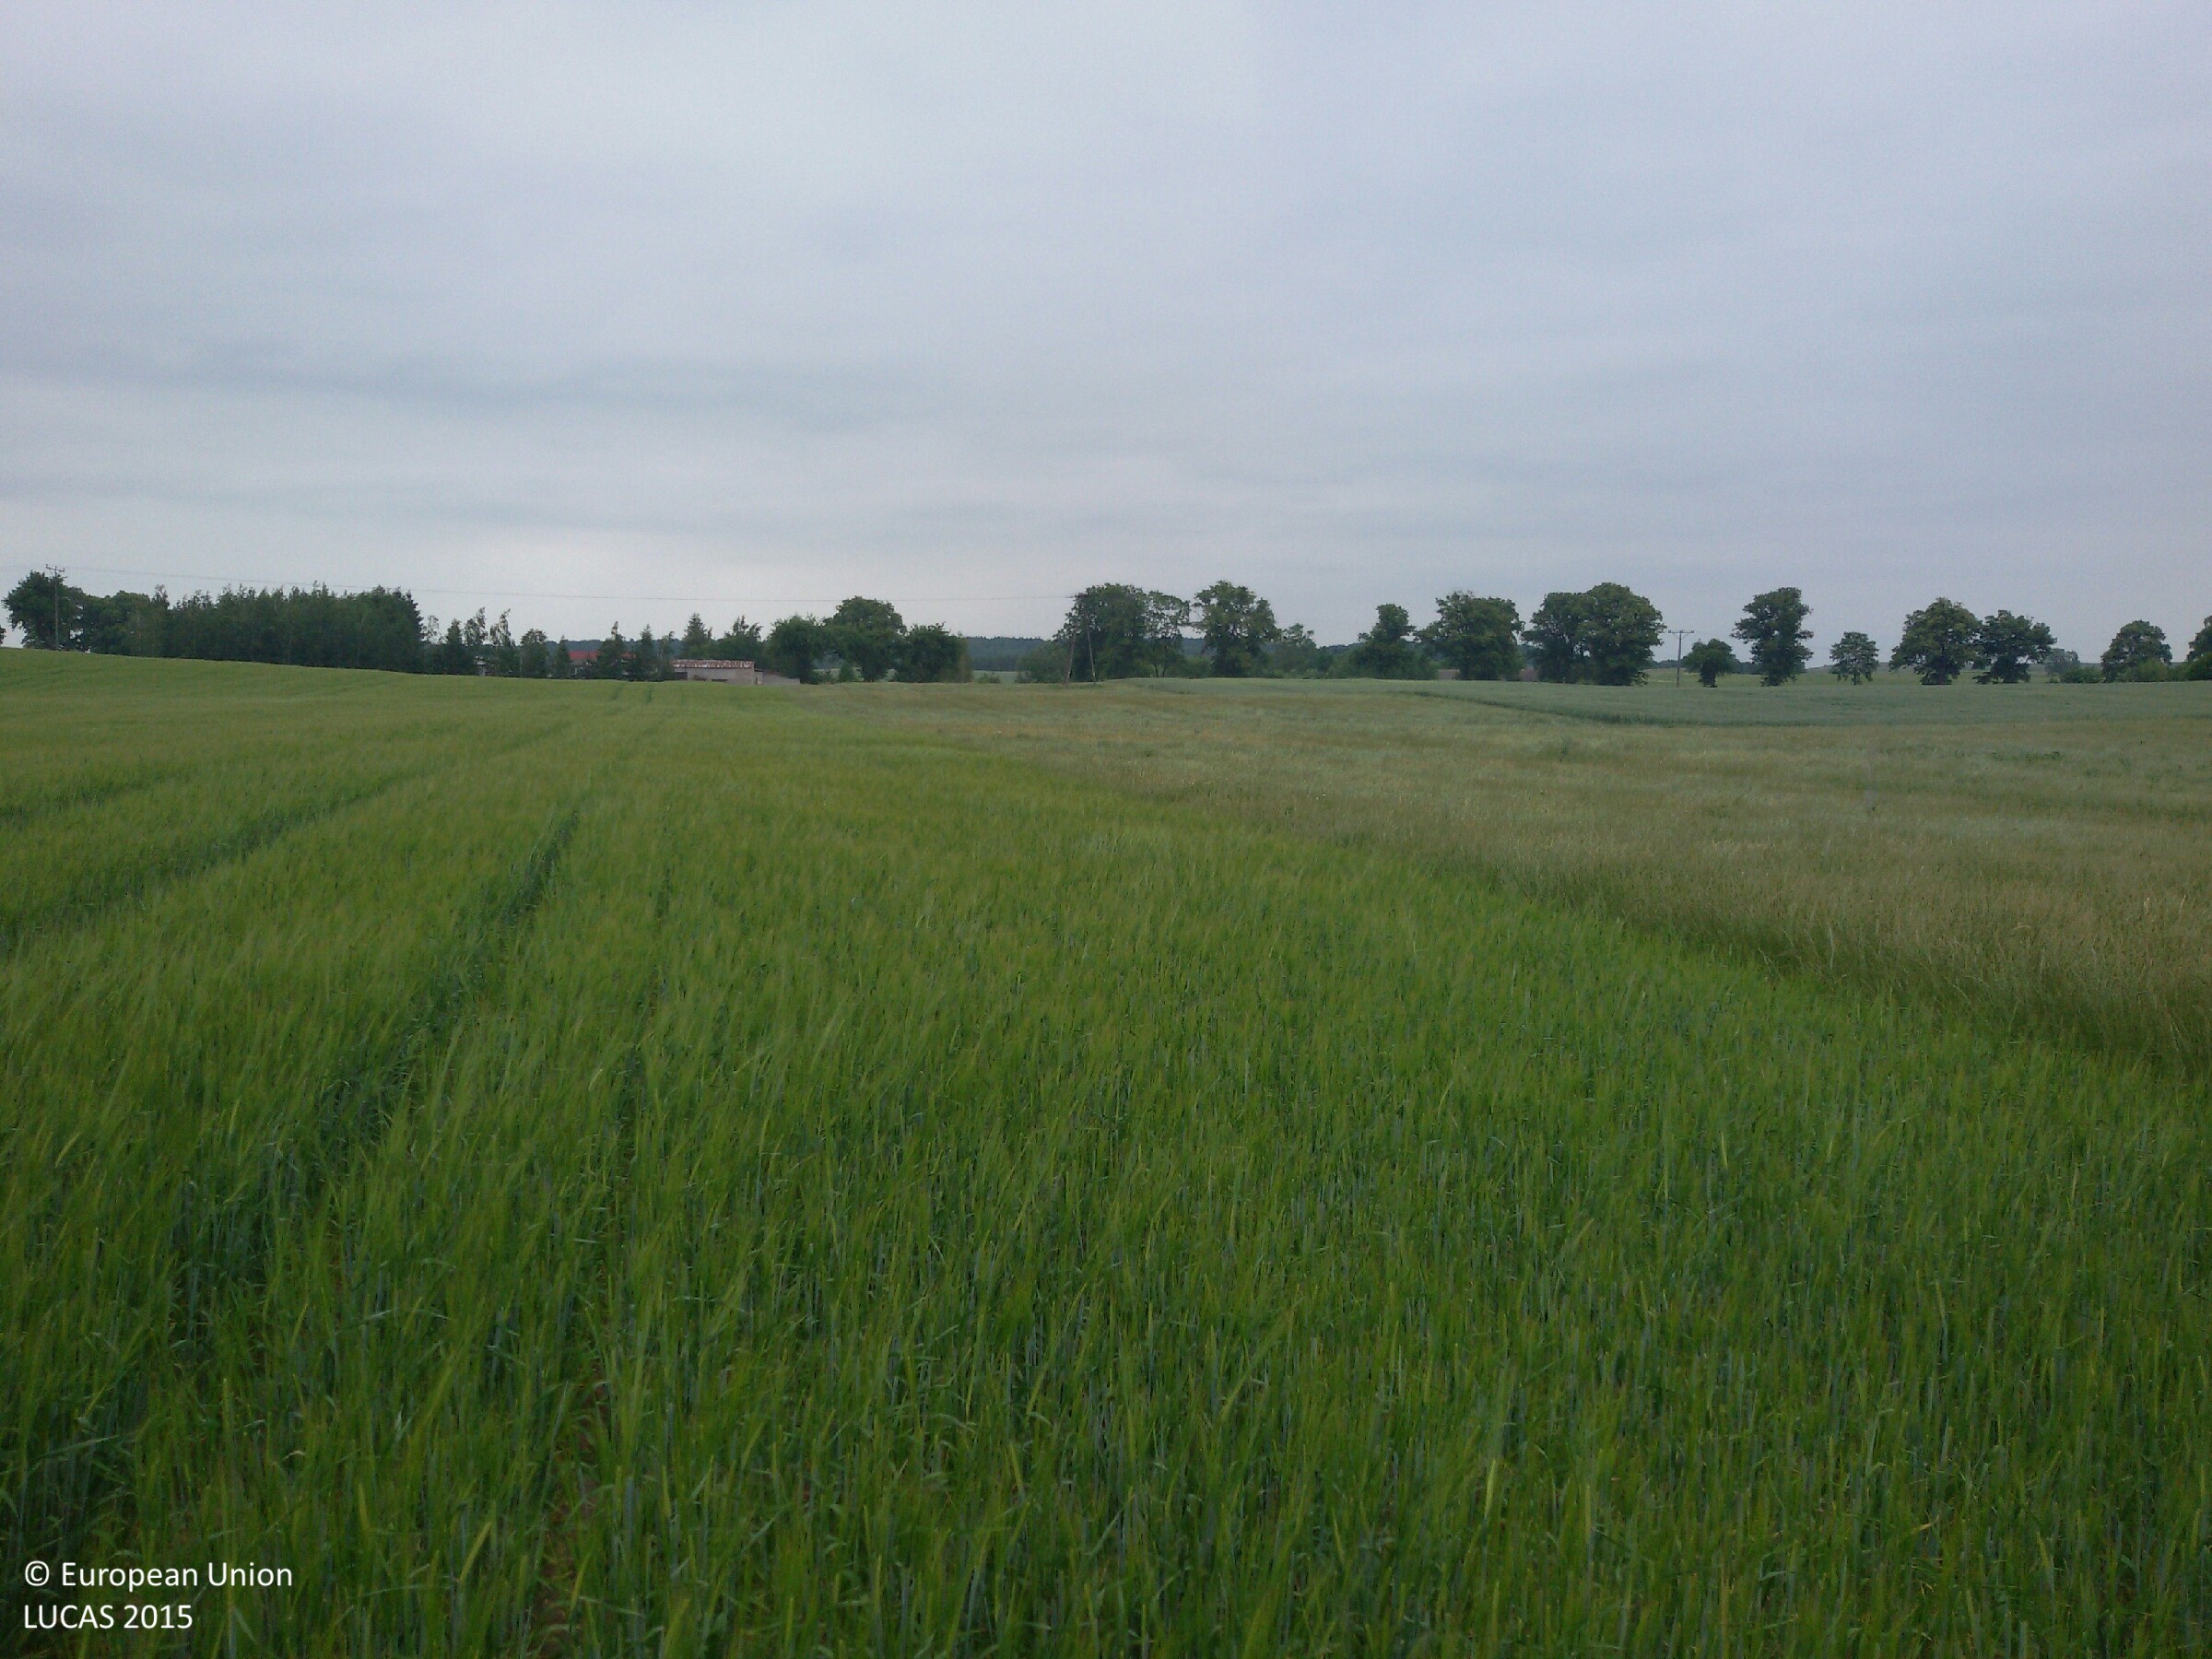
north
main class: Cropland
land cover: Barley
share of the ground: > 75 %
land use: Agriculture (excluding fallow land and kitchen gardens)
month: June
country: PL
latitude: 53.5009
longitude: 19.2356
